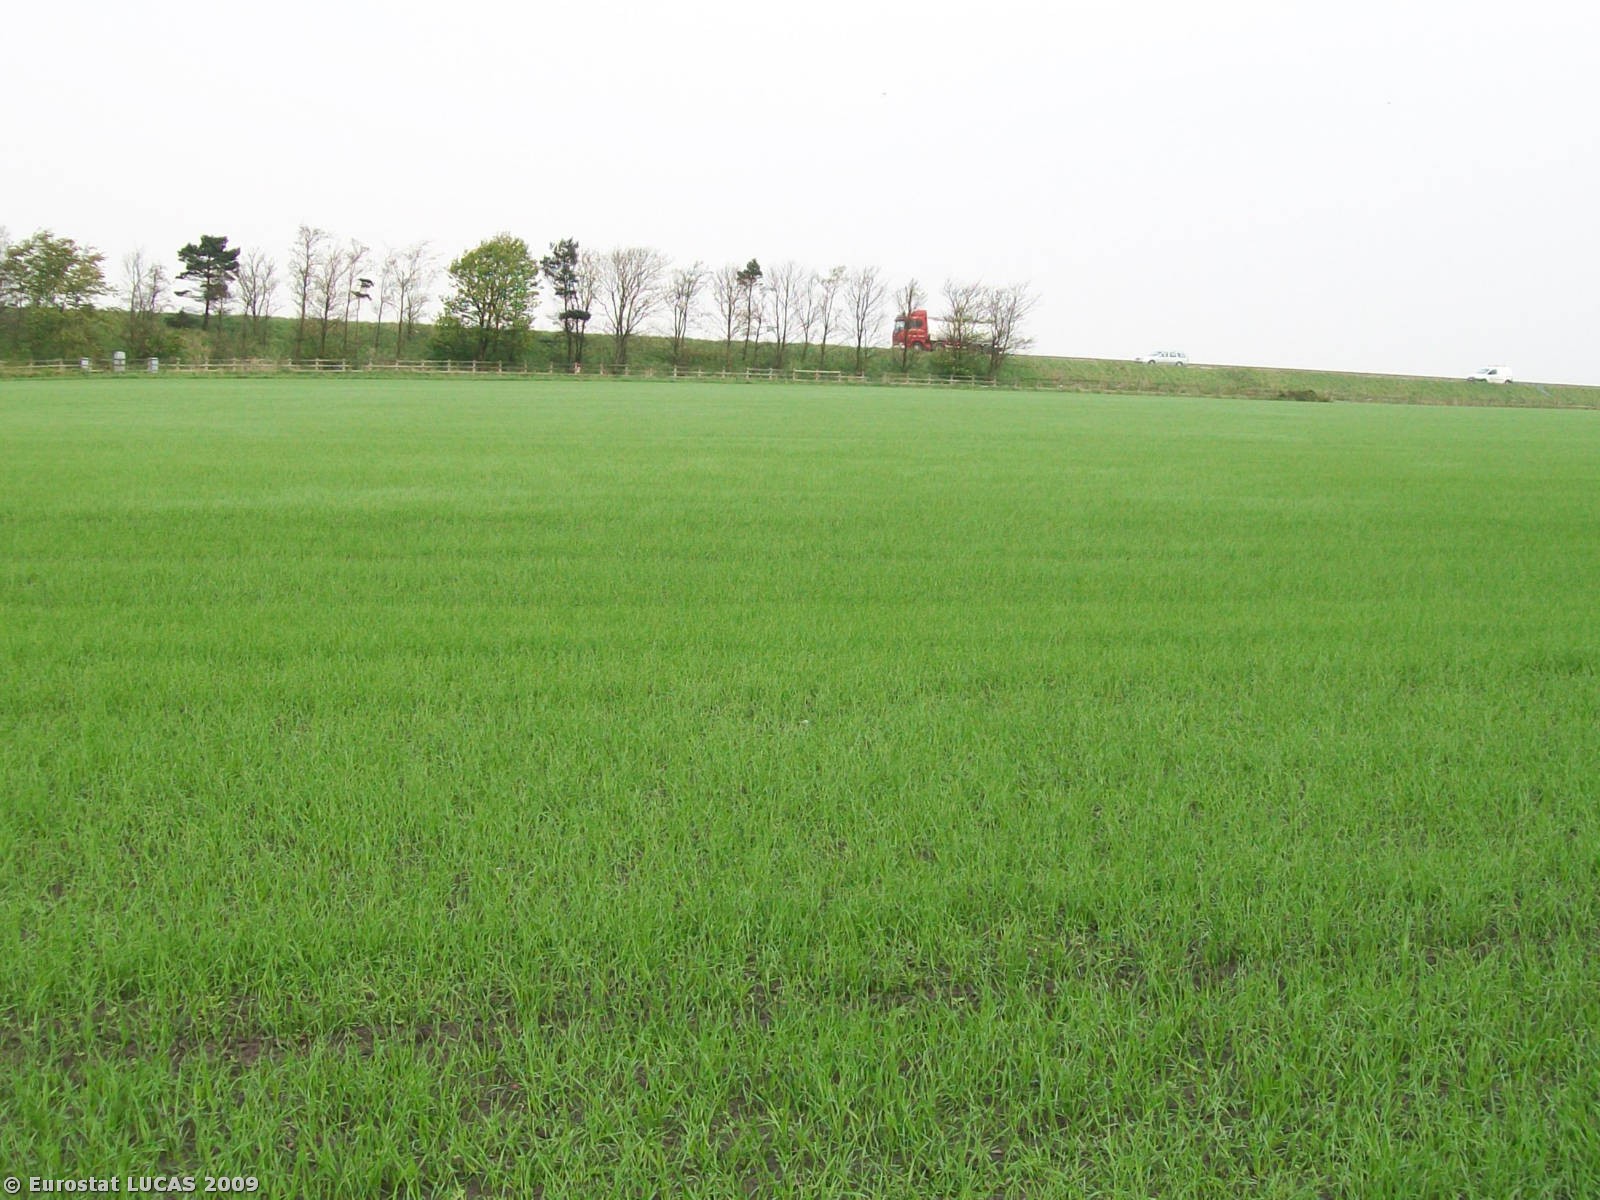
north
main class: Cropland
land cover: Common wheat
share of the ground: 50 - 75 %
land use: Agriculture (excluding fallow land and kitchen gardens)
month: April
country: GB
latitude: 53.5366
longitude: -2.8207
